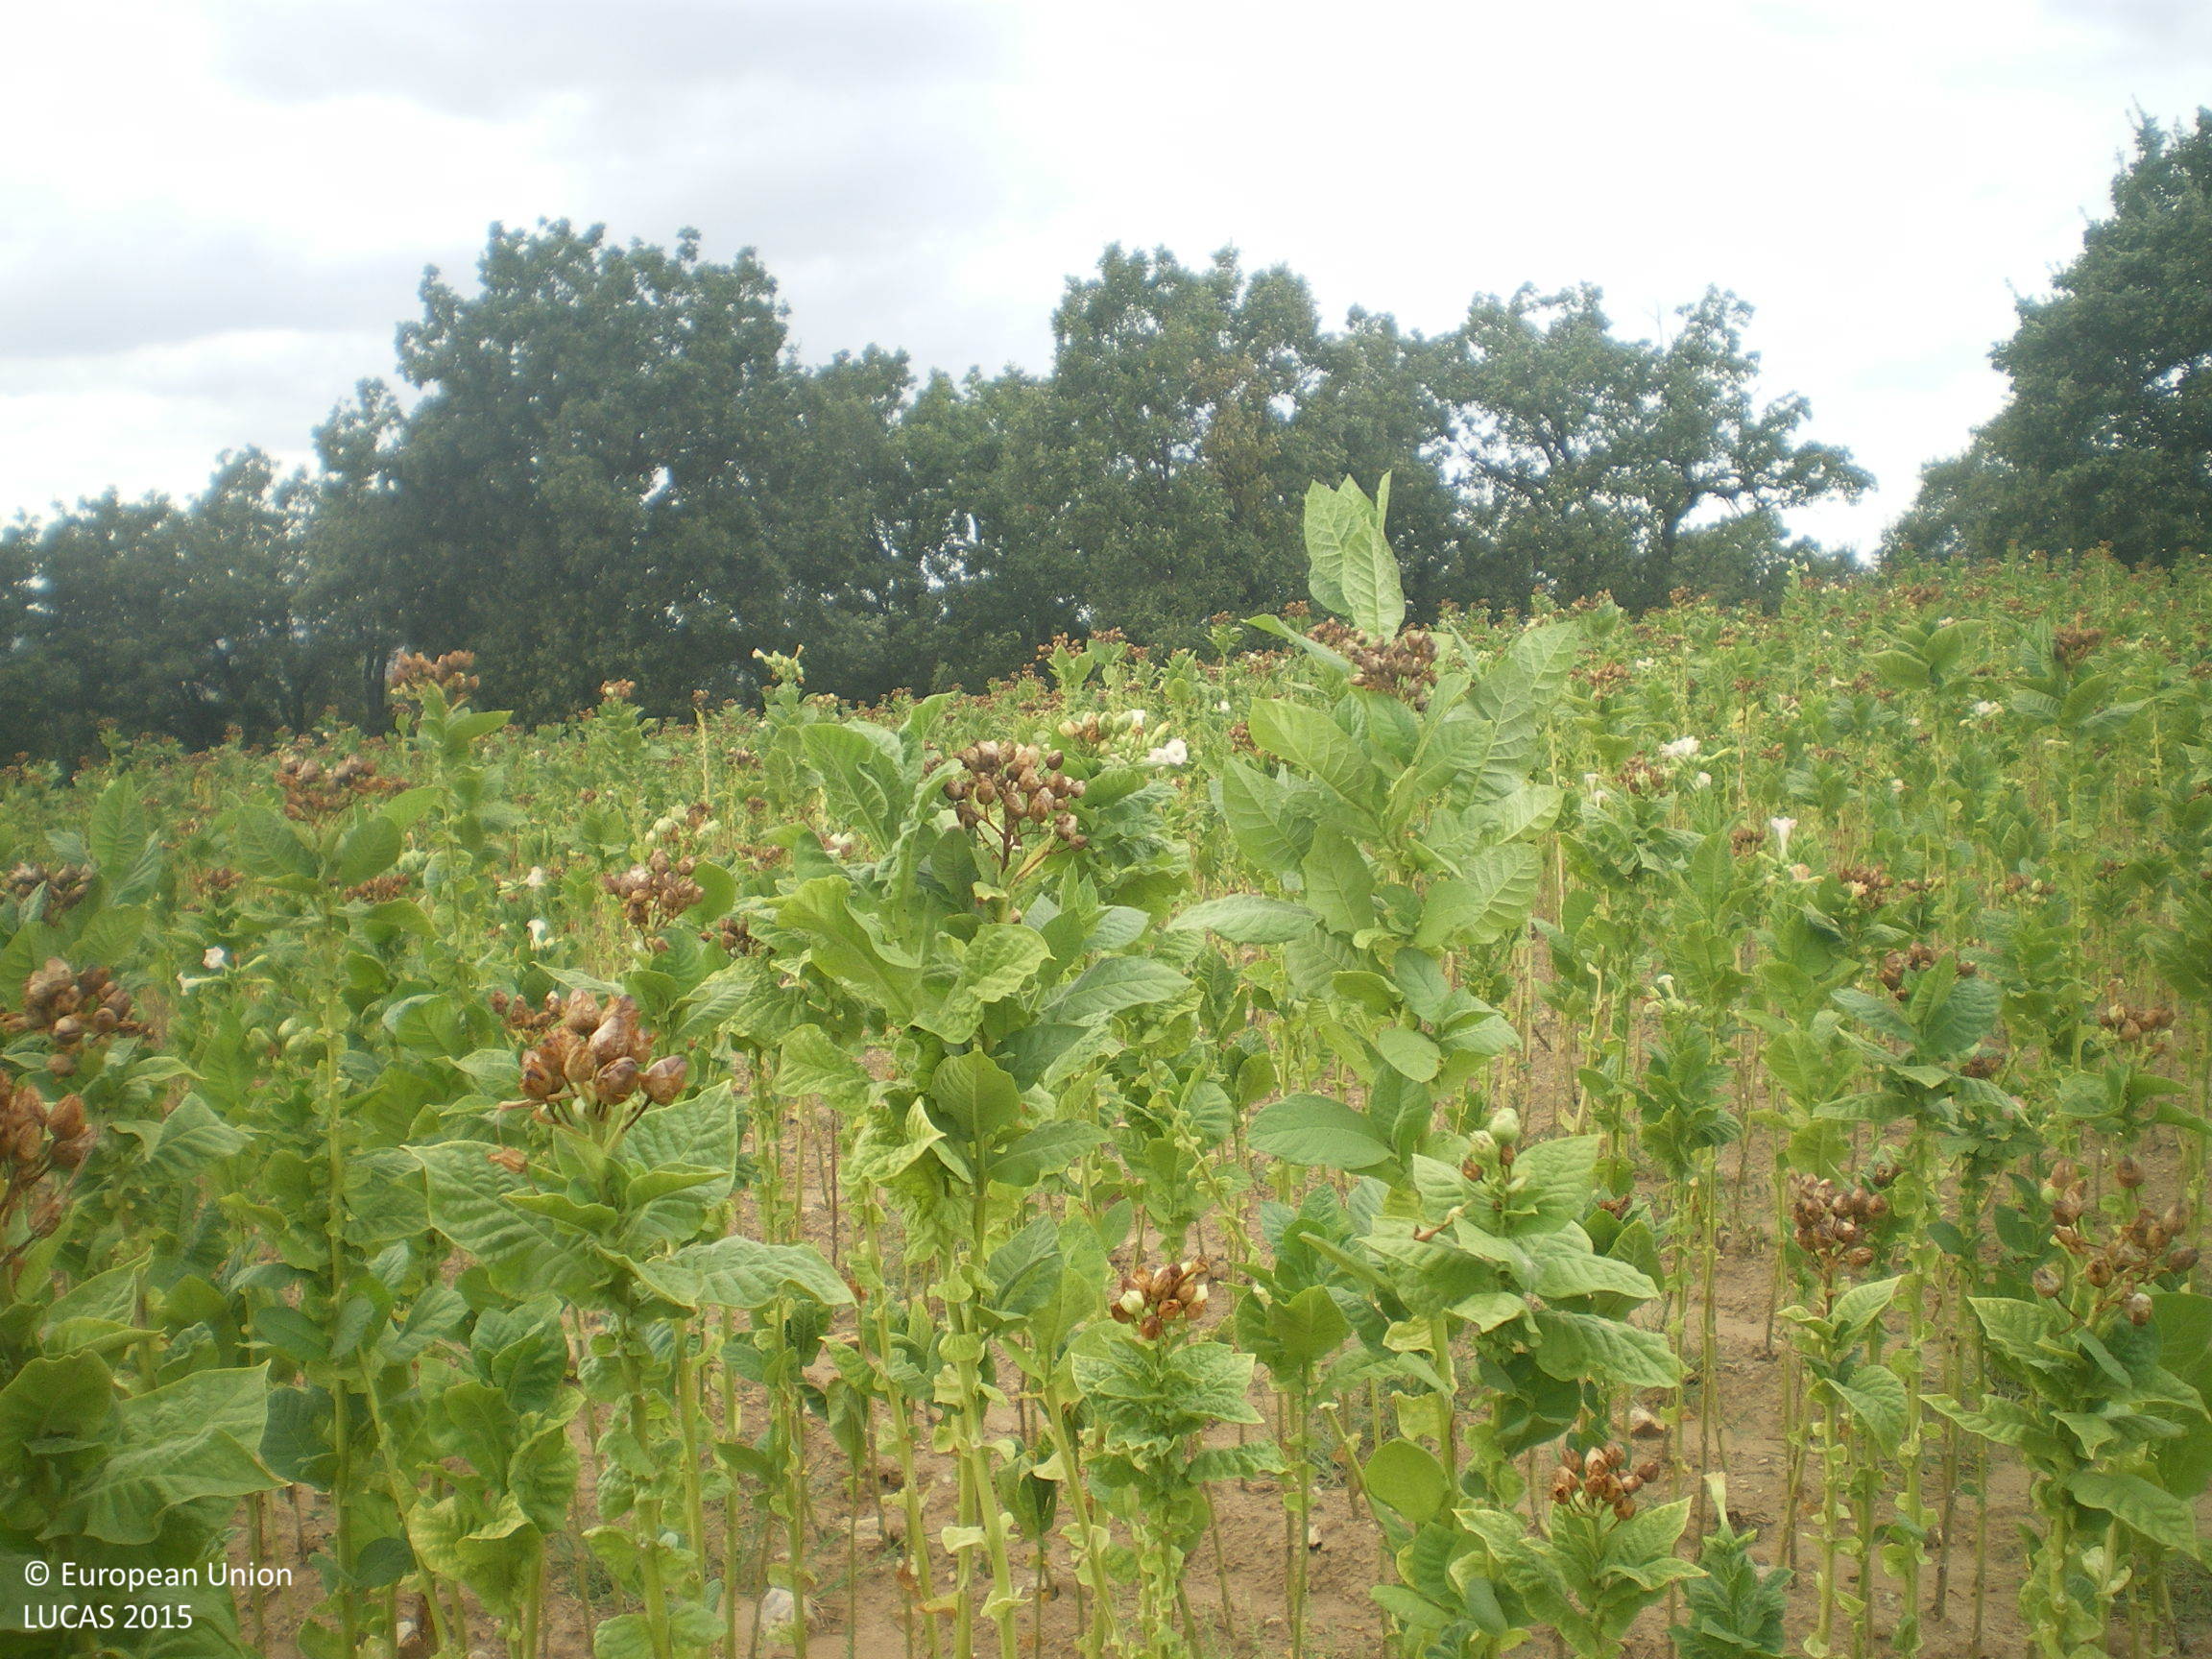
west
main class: Cropland
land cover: Tobacco
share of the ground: > 75 %
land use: Agriculture (excluding fallow land and kitchen gardens)
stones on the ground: > 50 %
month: September
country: BG
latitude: 41.9738
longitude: 25.9174
